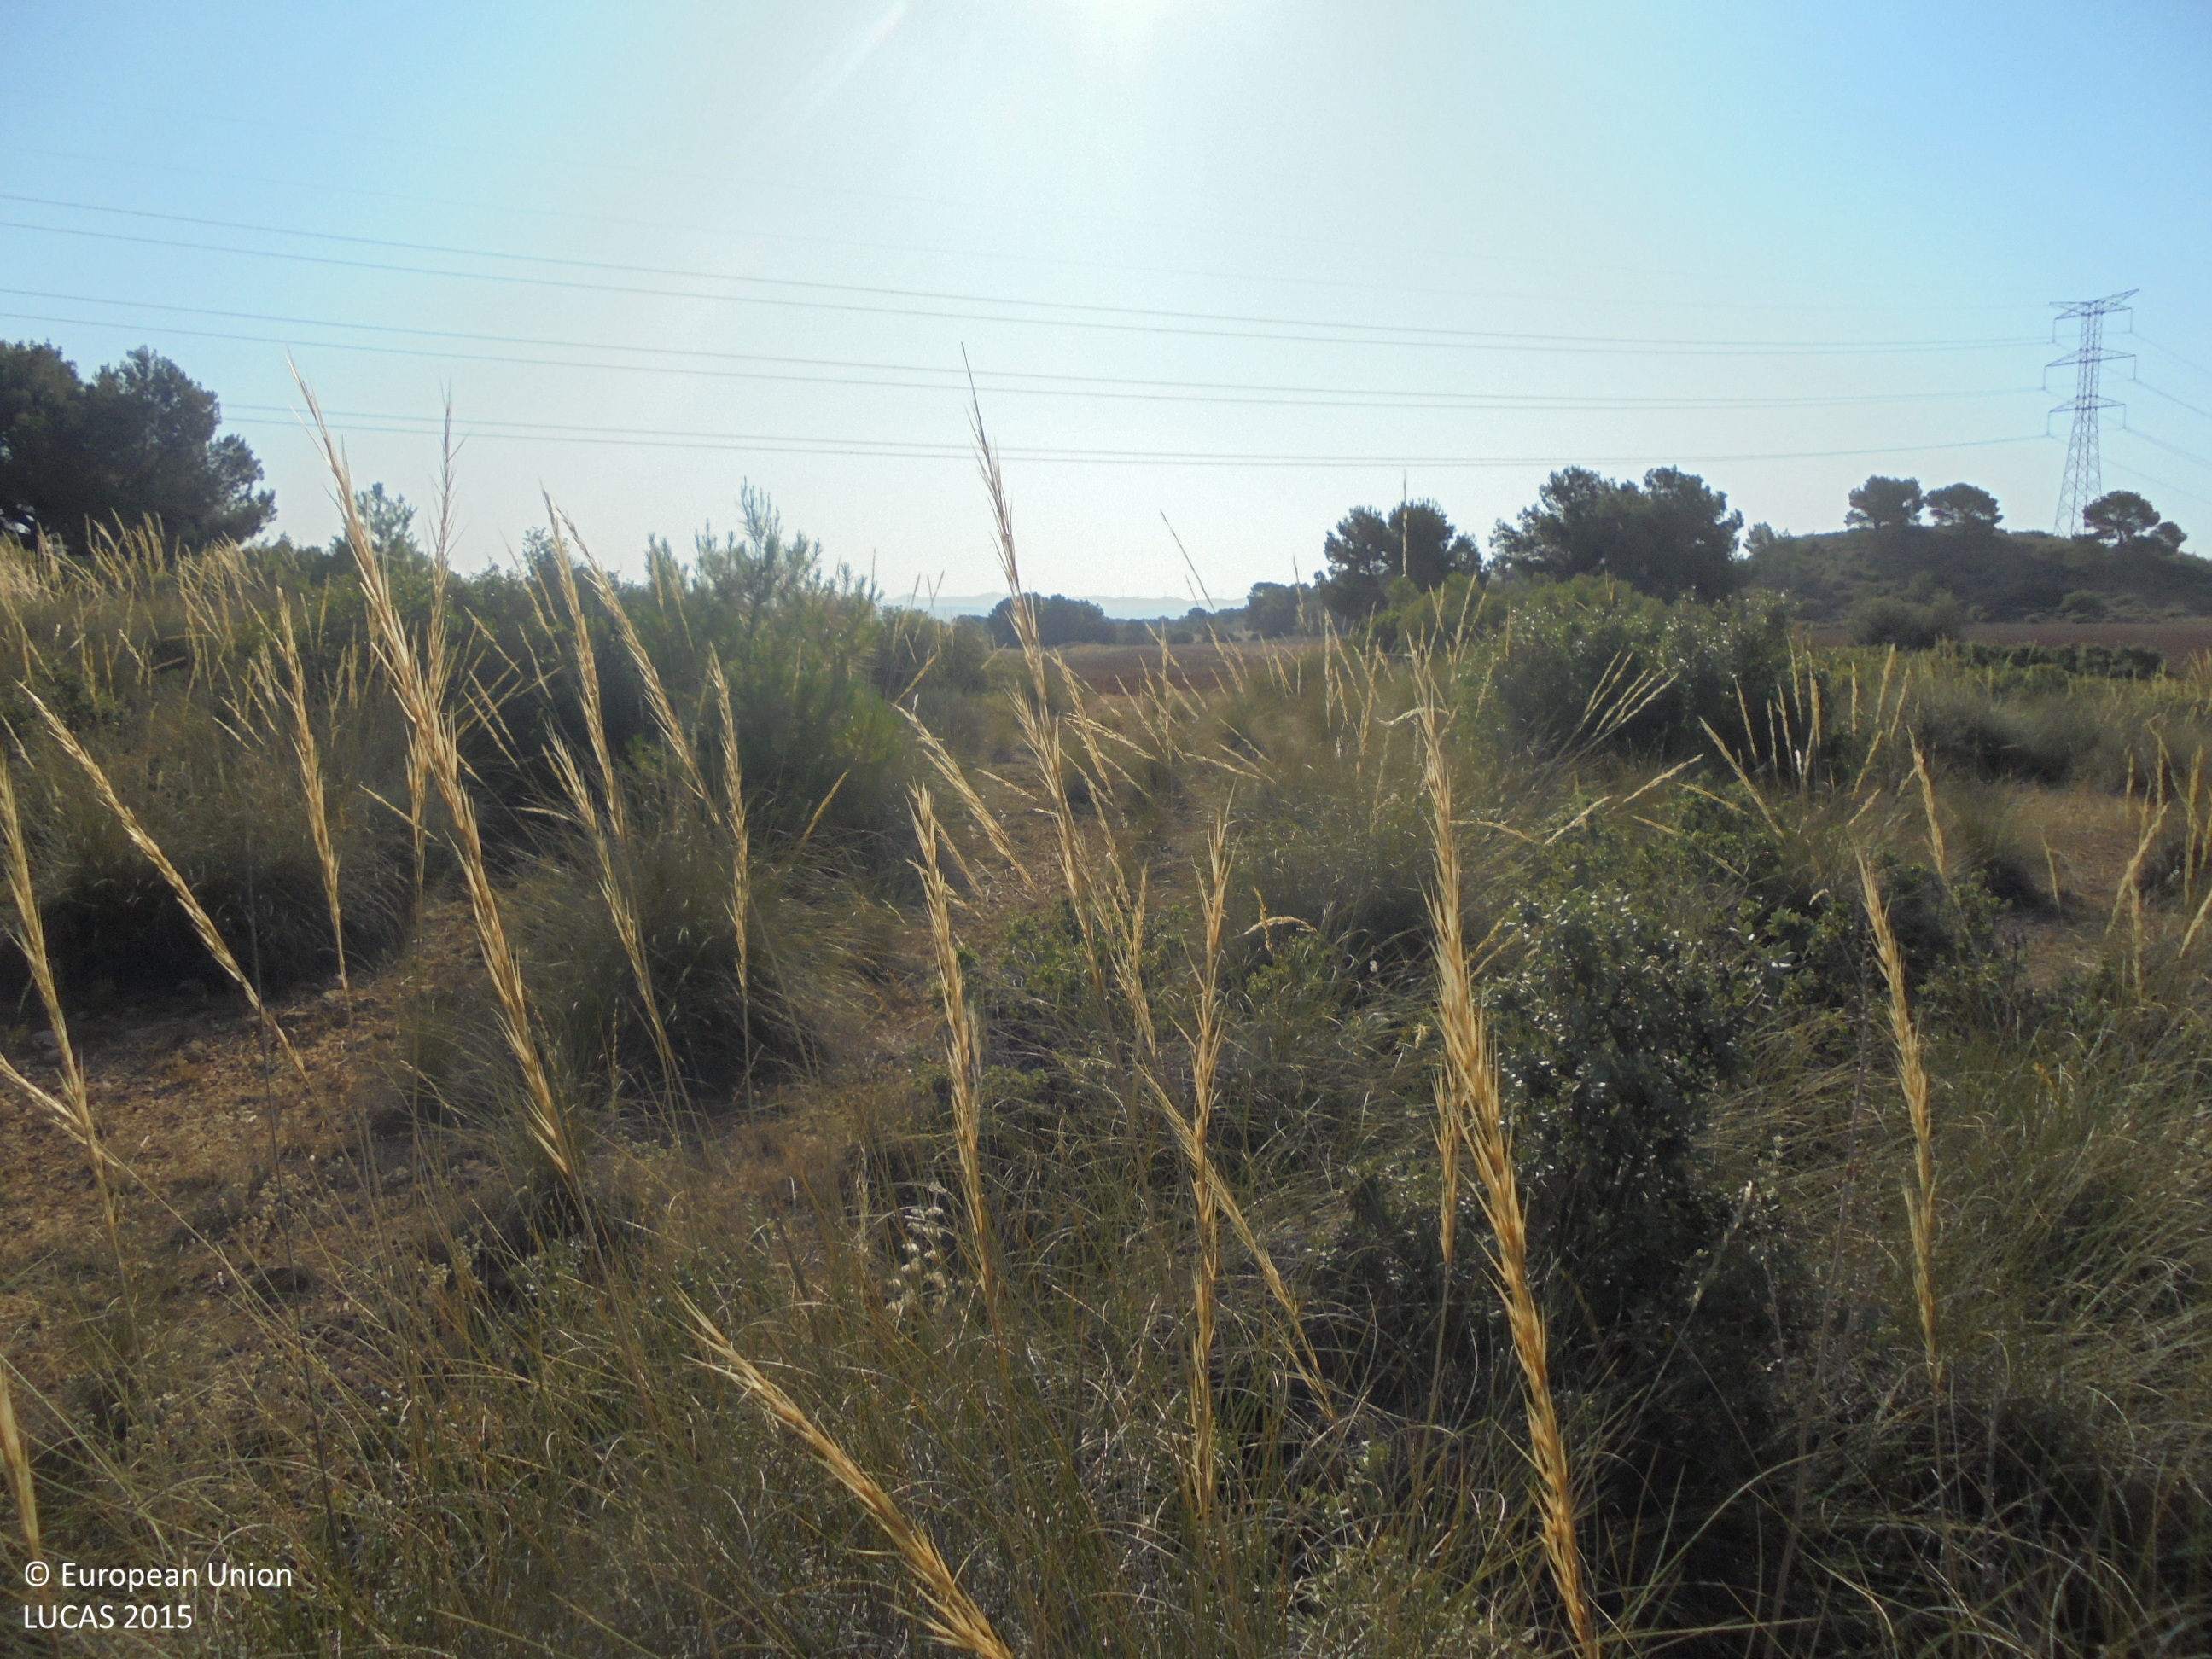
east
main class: Shrubland
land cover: Shrubland with sparse tree cover
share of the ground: > 75 %
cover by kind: shrubs 80 %, unconsolidated bare surface 15 %, coniferous forest trees 5 %
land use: Semi-natural and natural areas not in use
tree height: < 5 m
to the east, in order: Shrubland with sparse tree cover; Other bare soil; Dry stone walls; Other bare soil; Spontaneously vegetated surfaces; Other bare soil; Electric lines; Other bare soil
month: July
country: ES
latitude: 38.7056
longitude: -1.5515
